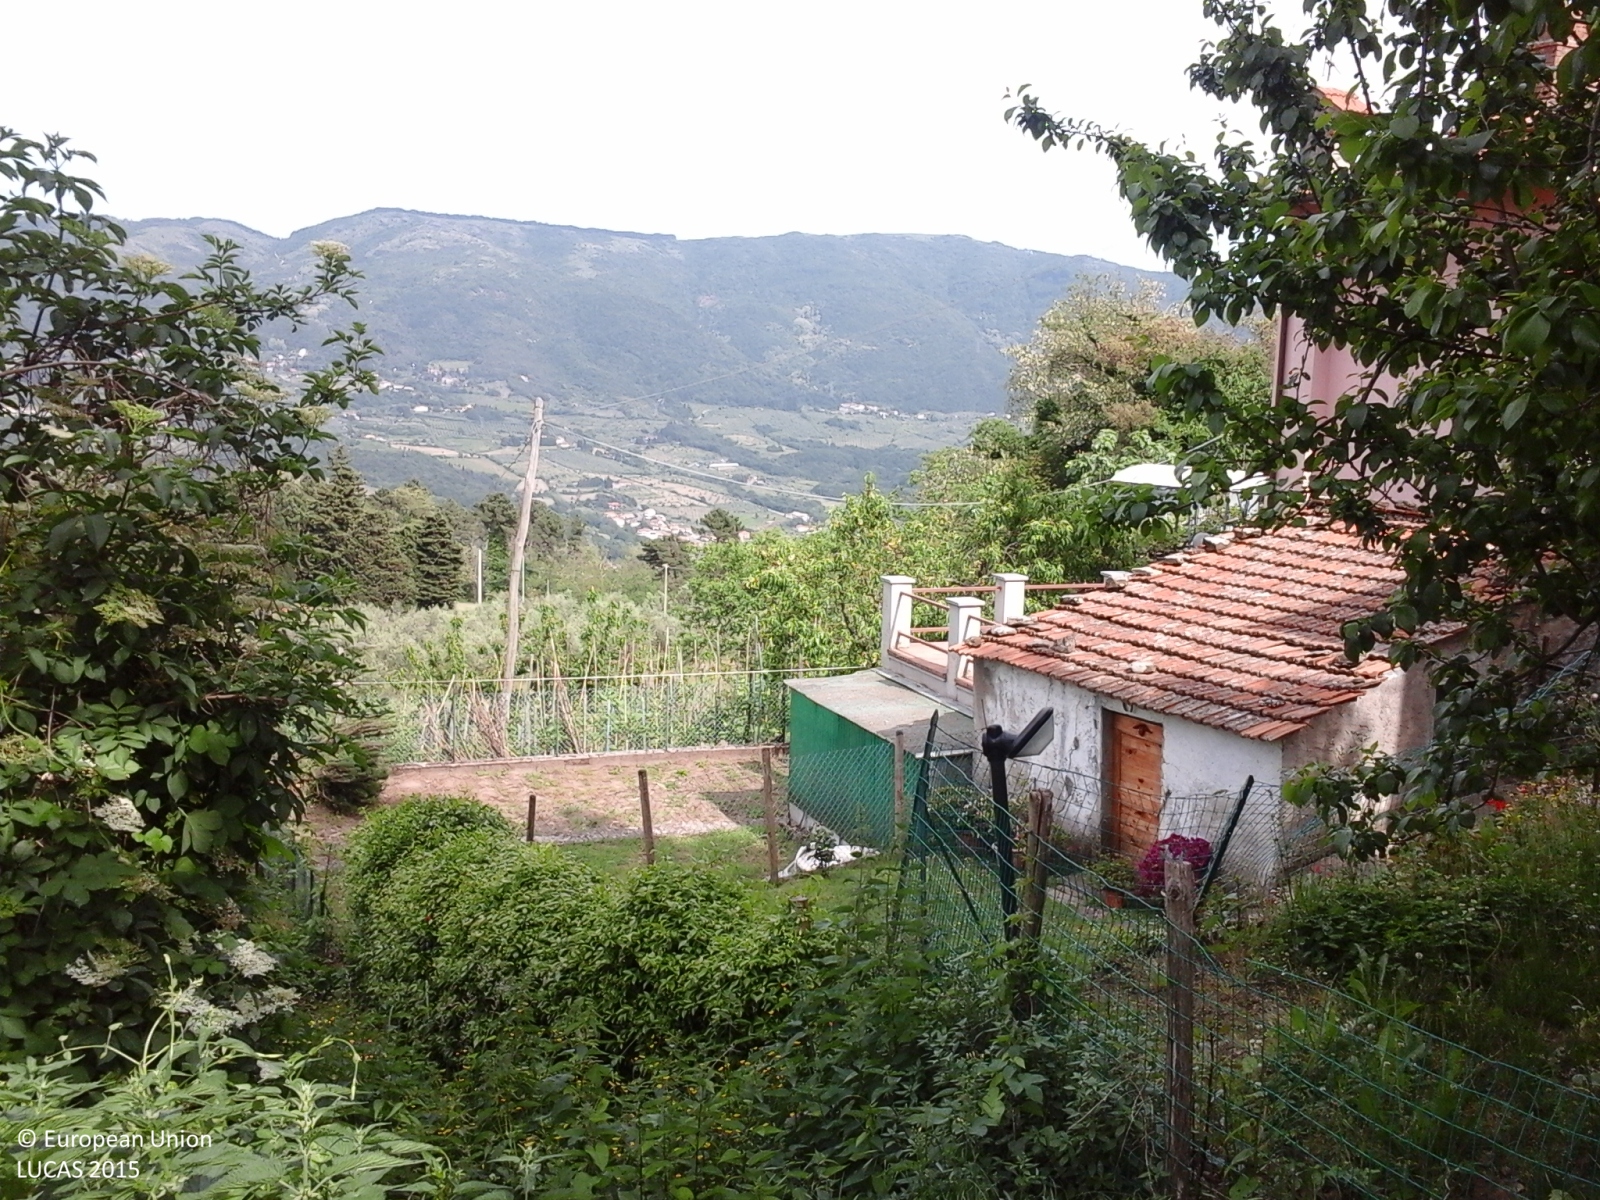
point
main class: Grassland
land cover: Grassland without tree/shrub cover
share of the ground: 10 - 25 %
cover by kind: herbaceous plants 100 %
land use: Residential
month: May
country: IT
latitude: 43.9658
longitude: 11.1065
